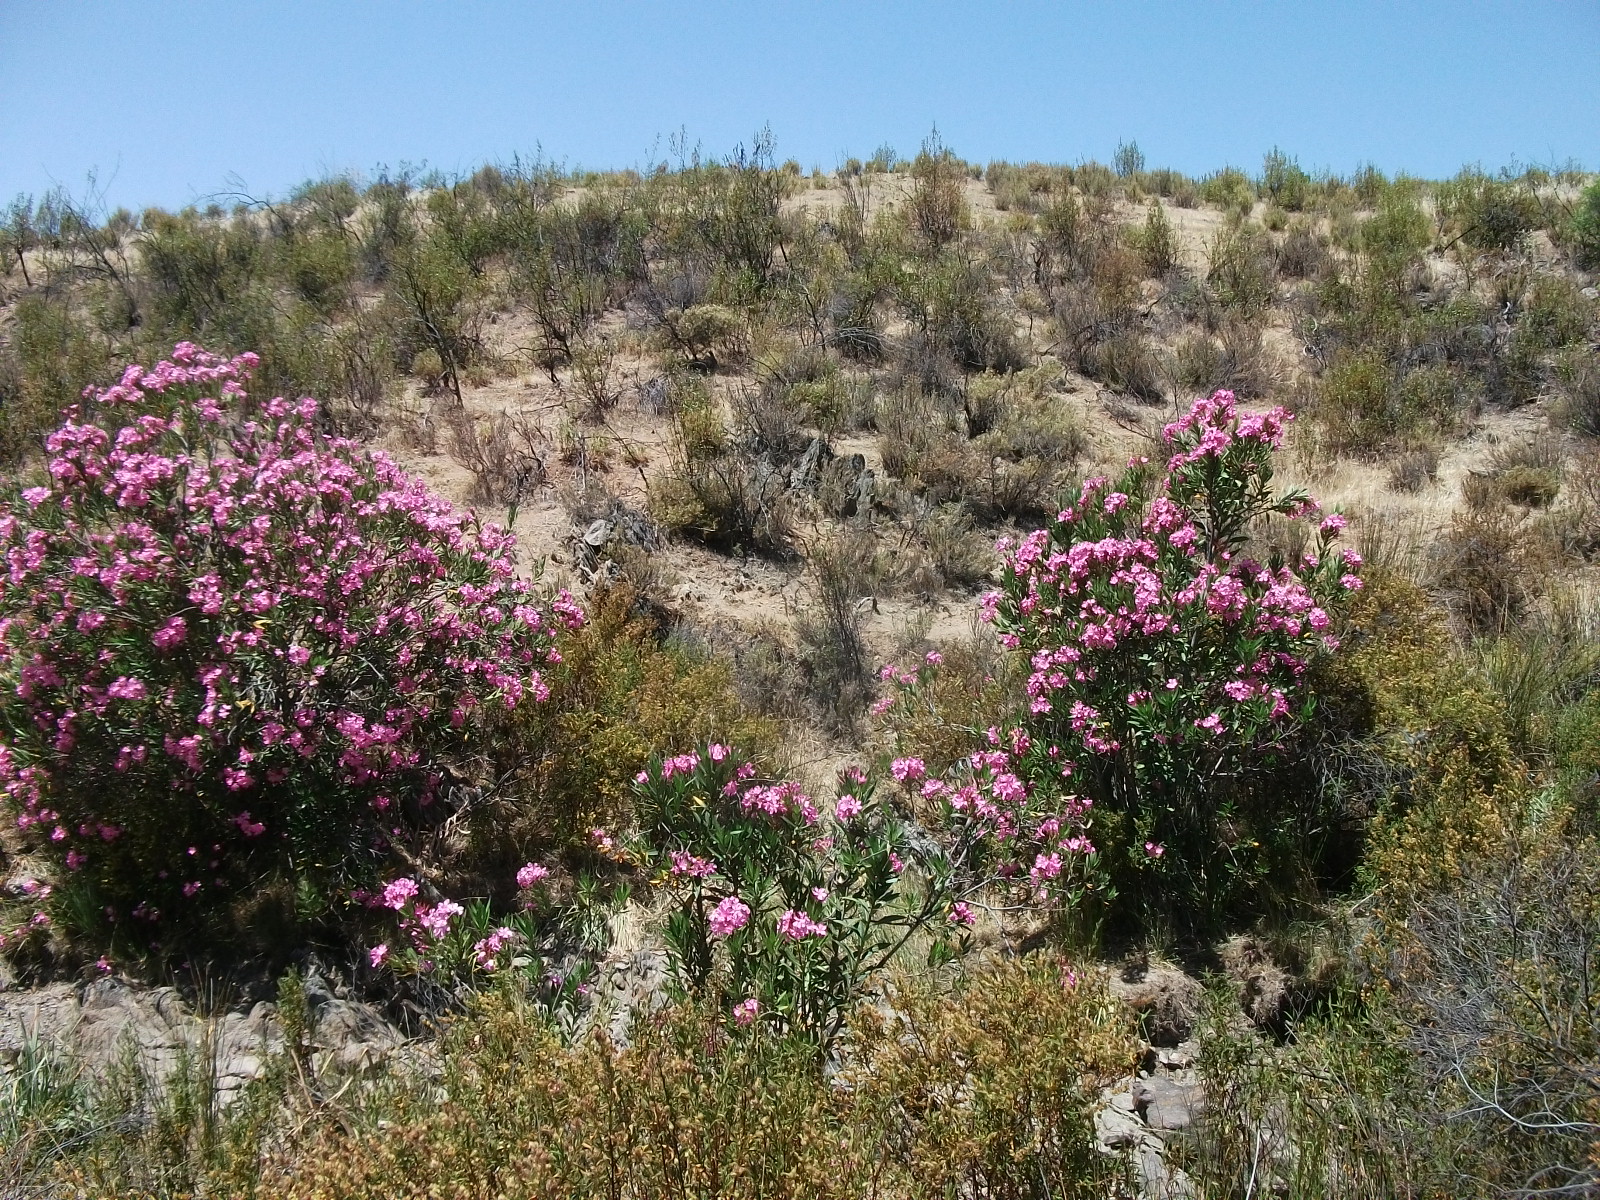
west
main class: Shrubland
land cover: Shrubland without tree cover
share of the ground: 25 - 50 %
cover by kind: shrubs 45 %, herbaceous plants 40 %, unconsolidated bare surface 15 %
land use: Agriculture (excluding fallow land and kitchen gardens)
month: June
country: ES
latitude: 37.5670
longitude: -6.9246
